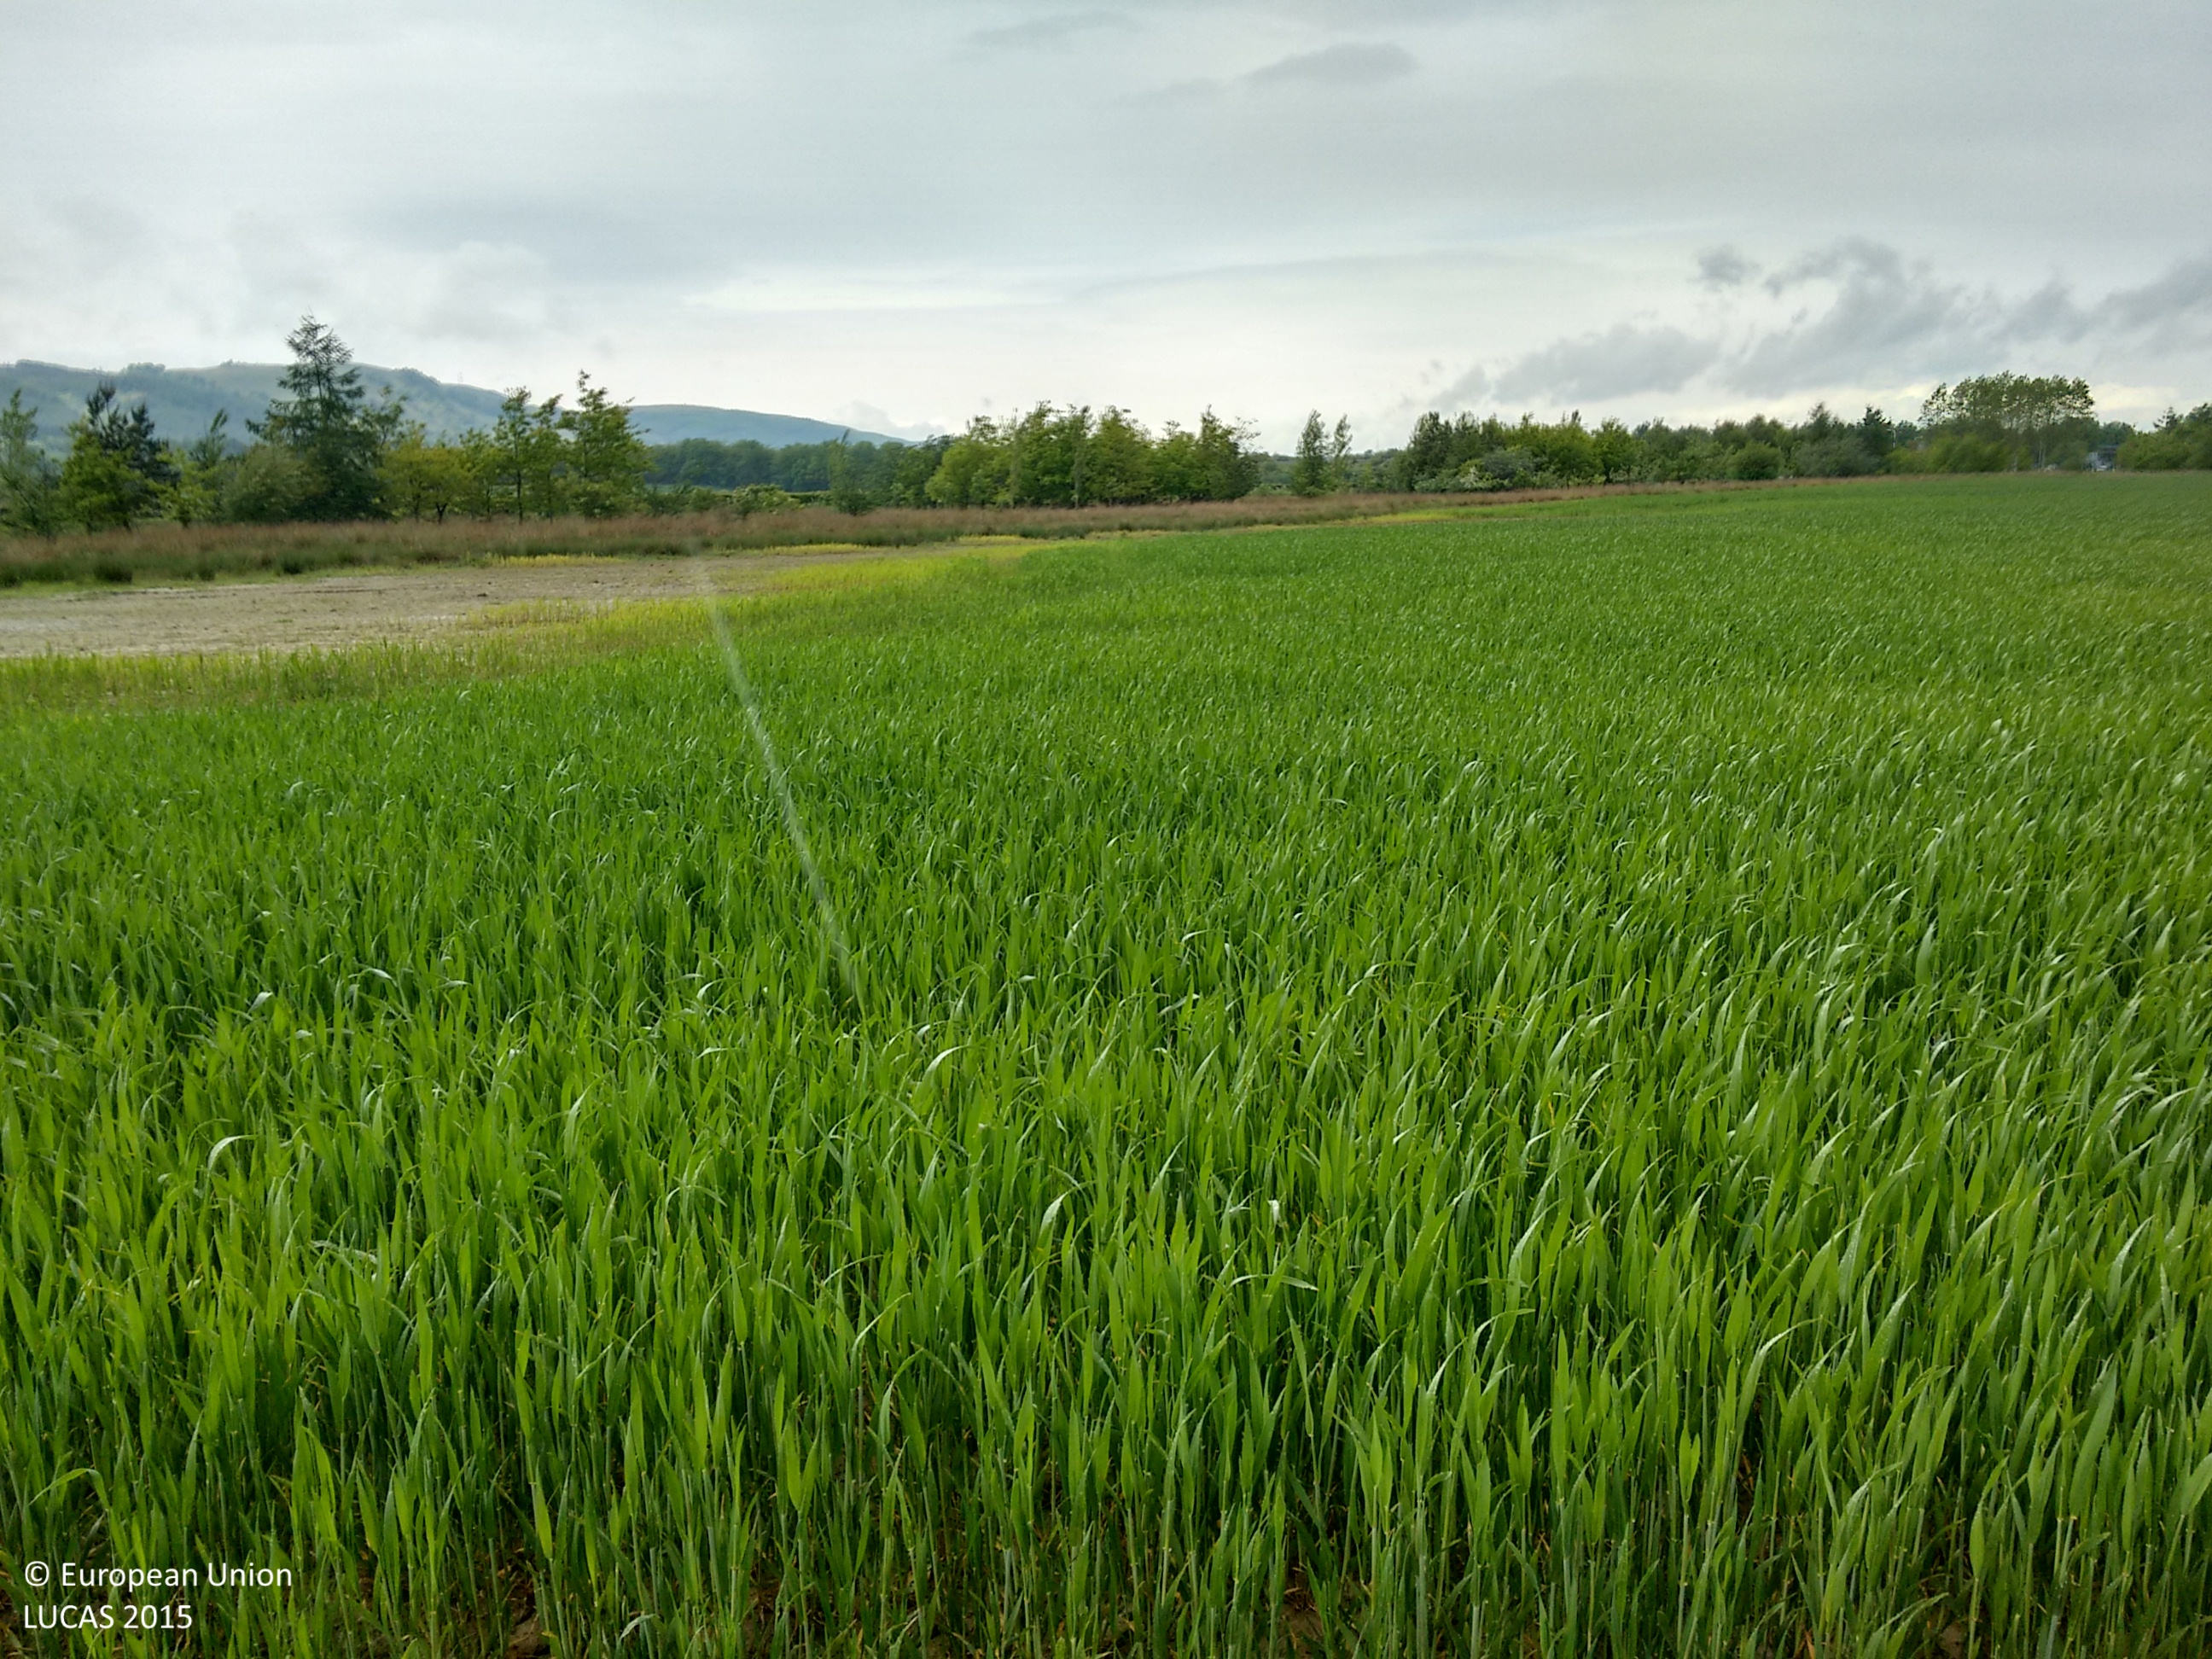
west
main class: Cropland
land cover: Common wheat
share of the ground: > 75 %
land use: Agriculture (excluding fallow land and kitchen gardens)
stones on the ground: < 10 %
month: June
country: GB
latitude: 56.3401
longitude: -3.3875
